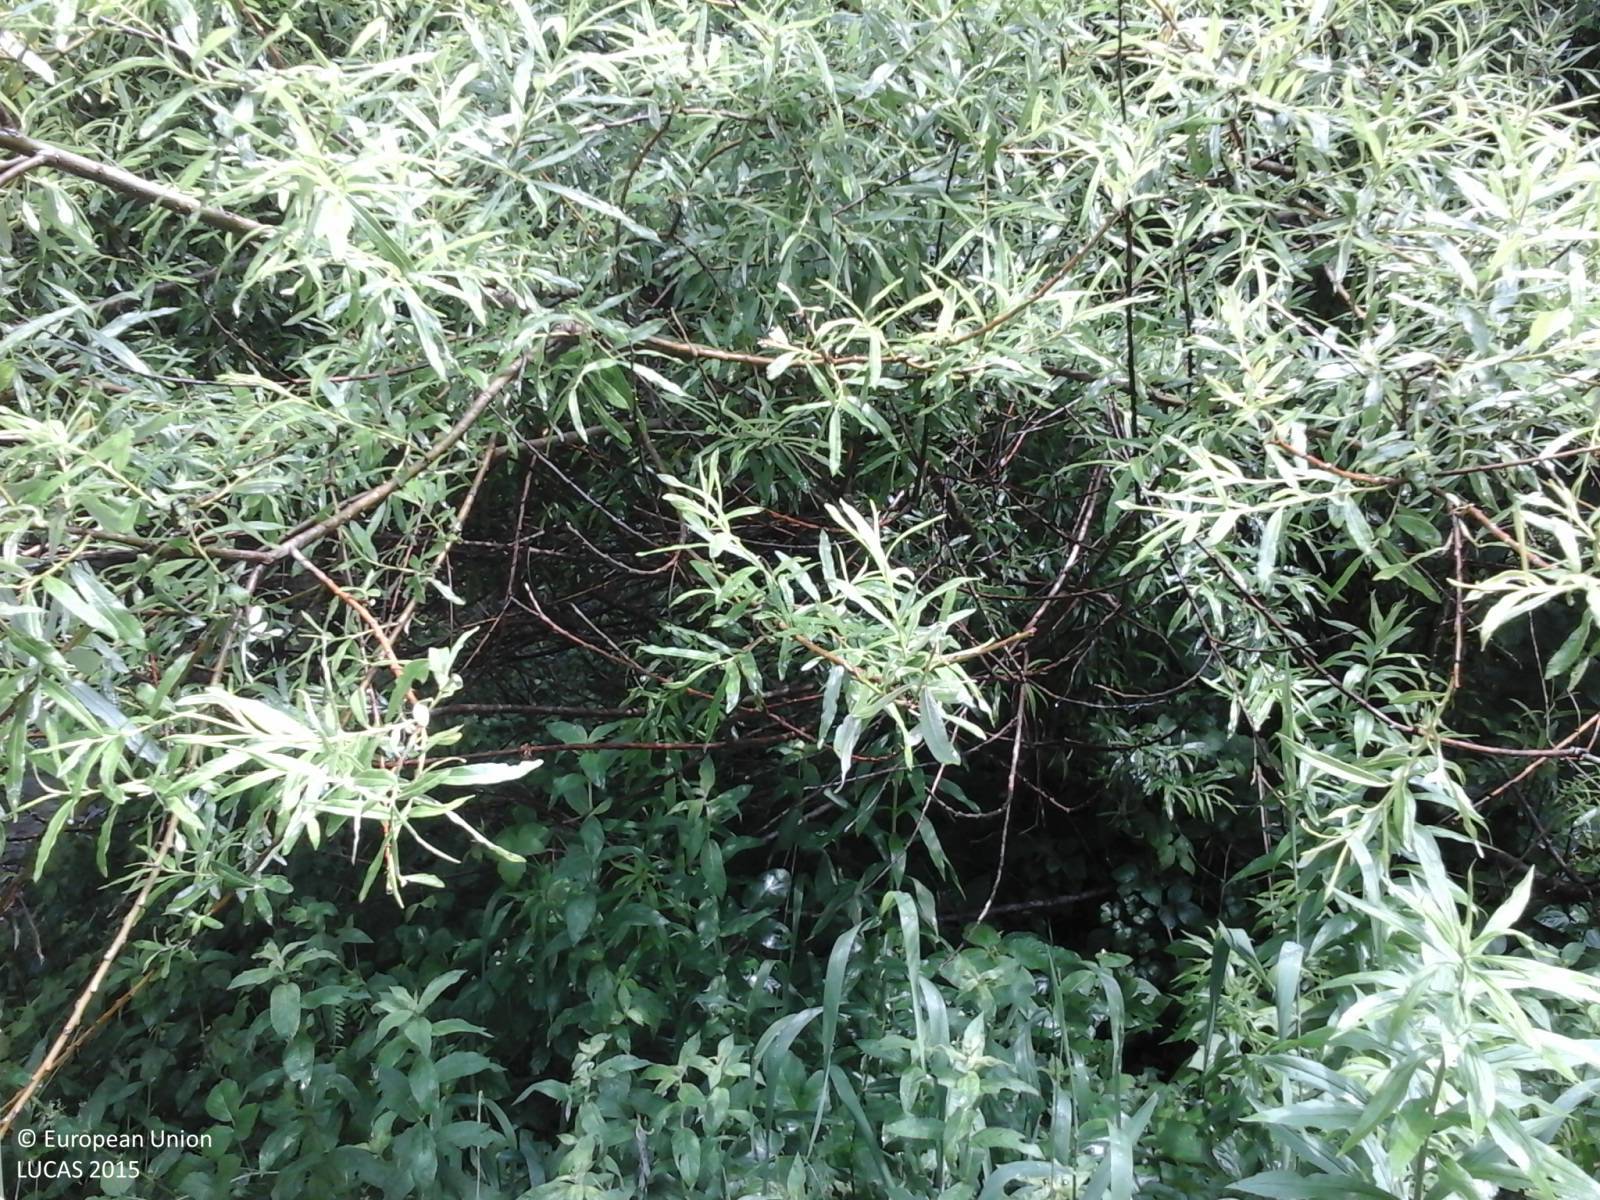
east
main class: Woodland
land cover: Broadleaved woodland
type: thermophilous deciduous forest
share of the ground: > 75 %
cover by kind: broadleaved forest trees 80 %, shrubs 10 %, herbaceous plants 10 %
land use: Semi-natural and natural areas not in use
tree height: > 5 m
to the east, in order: Broadleaved woodland; Other mixed woodland; Ditches and canals; Inland fresh running water; Grassland without tree/shrub cover; Paved roads, cycling and walking lanes
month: June
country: IT
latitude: 46.5085
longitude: 13.5548
